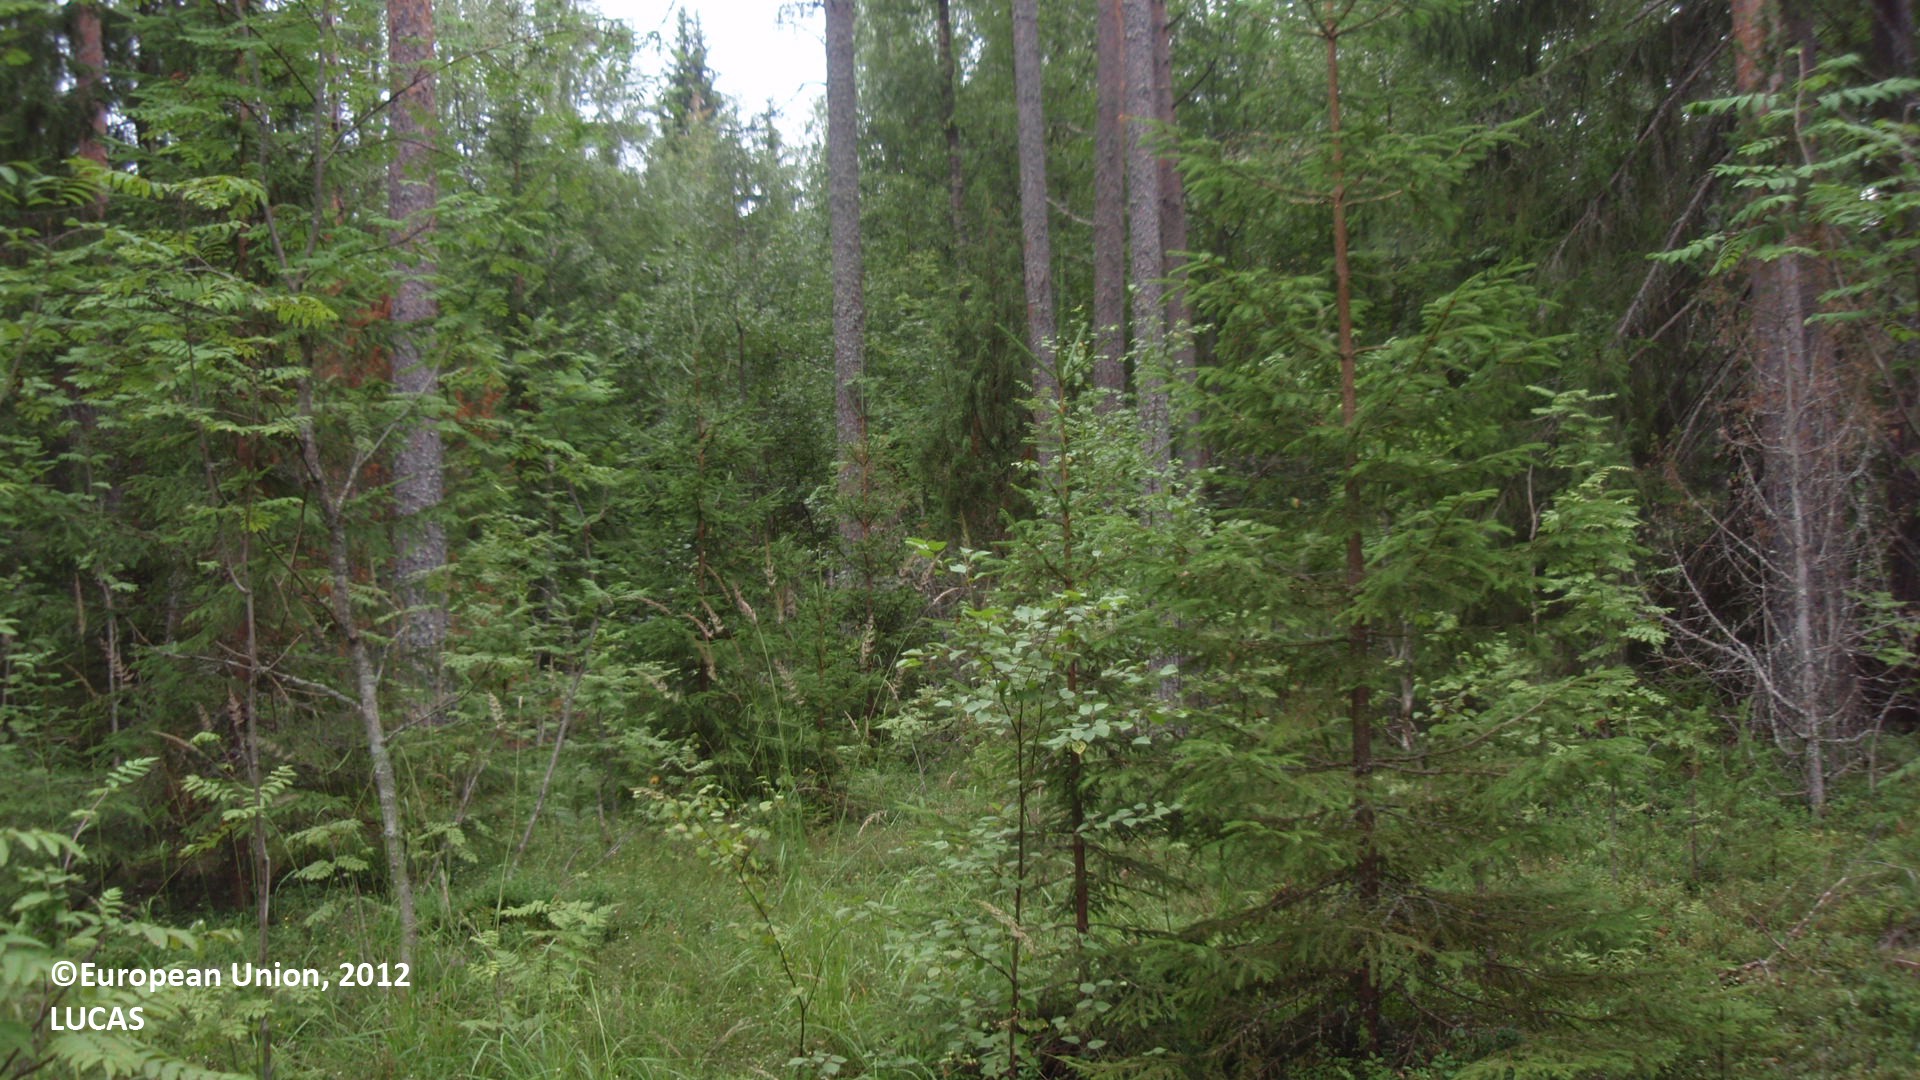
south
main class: Woodland
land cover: Pine dominated mixed woodland
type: boreal forest
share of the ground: 50 - 75 %
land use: Forestry
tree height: > 5 m
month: August
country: FI
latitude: 61.2451
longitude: 27.7609
